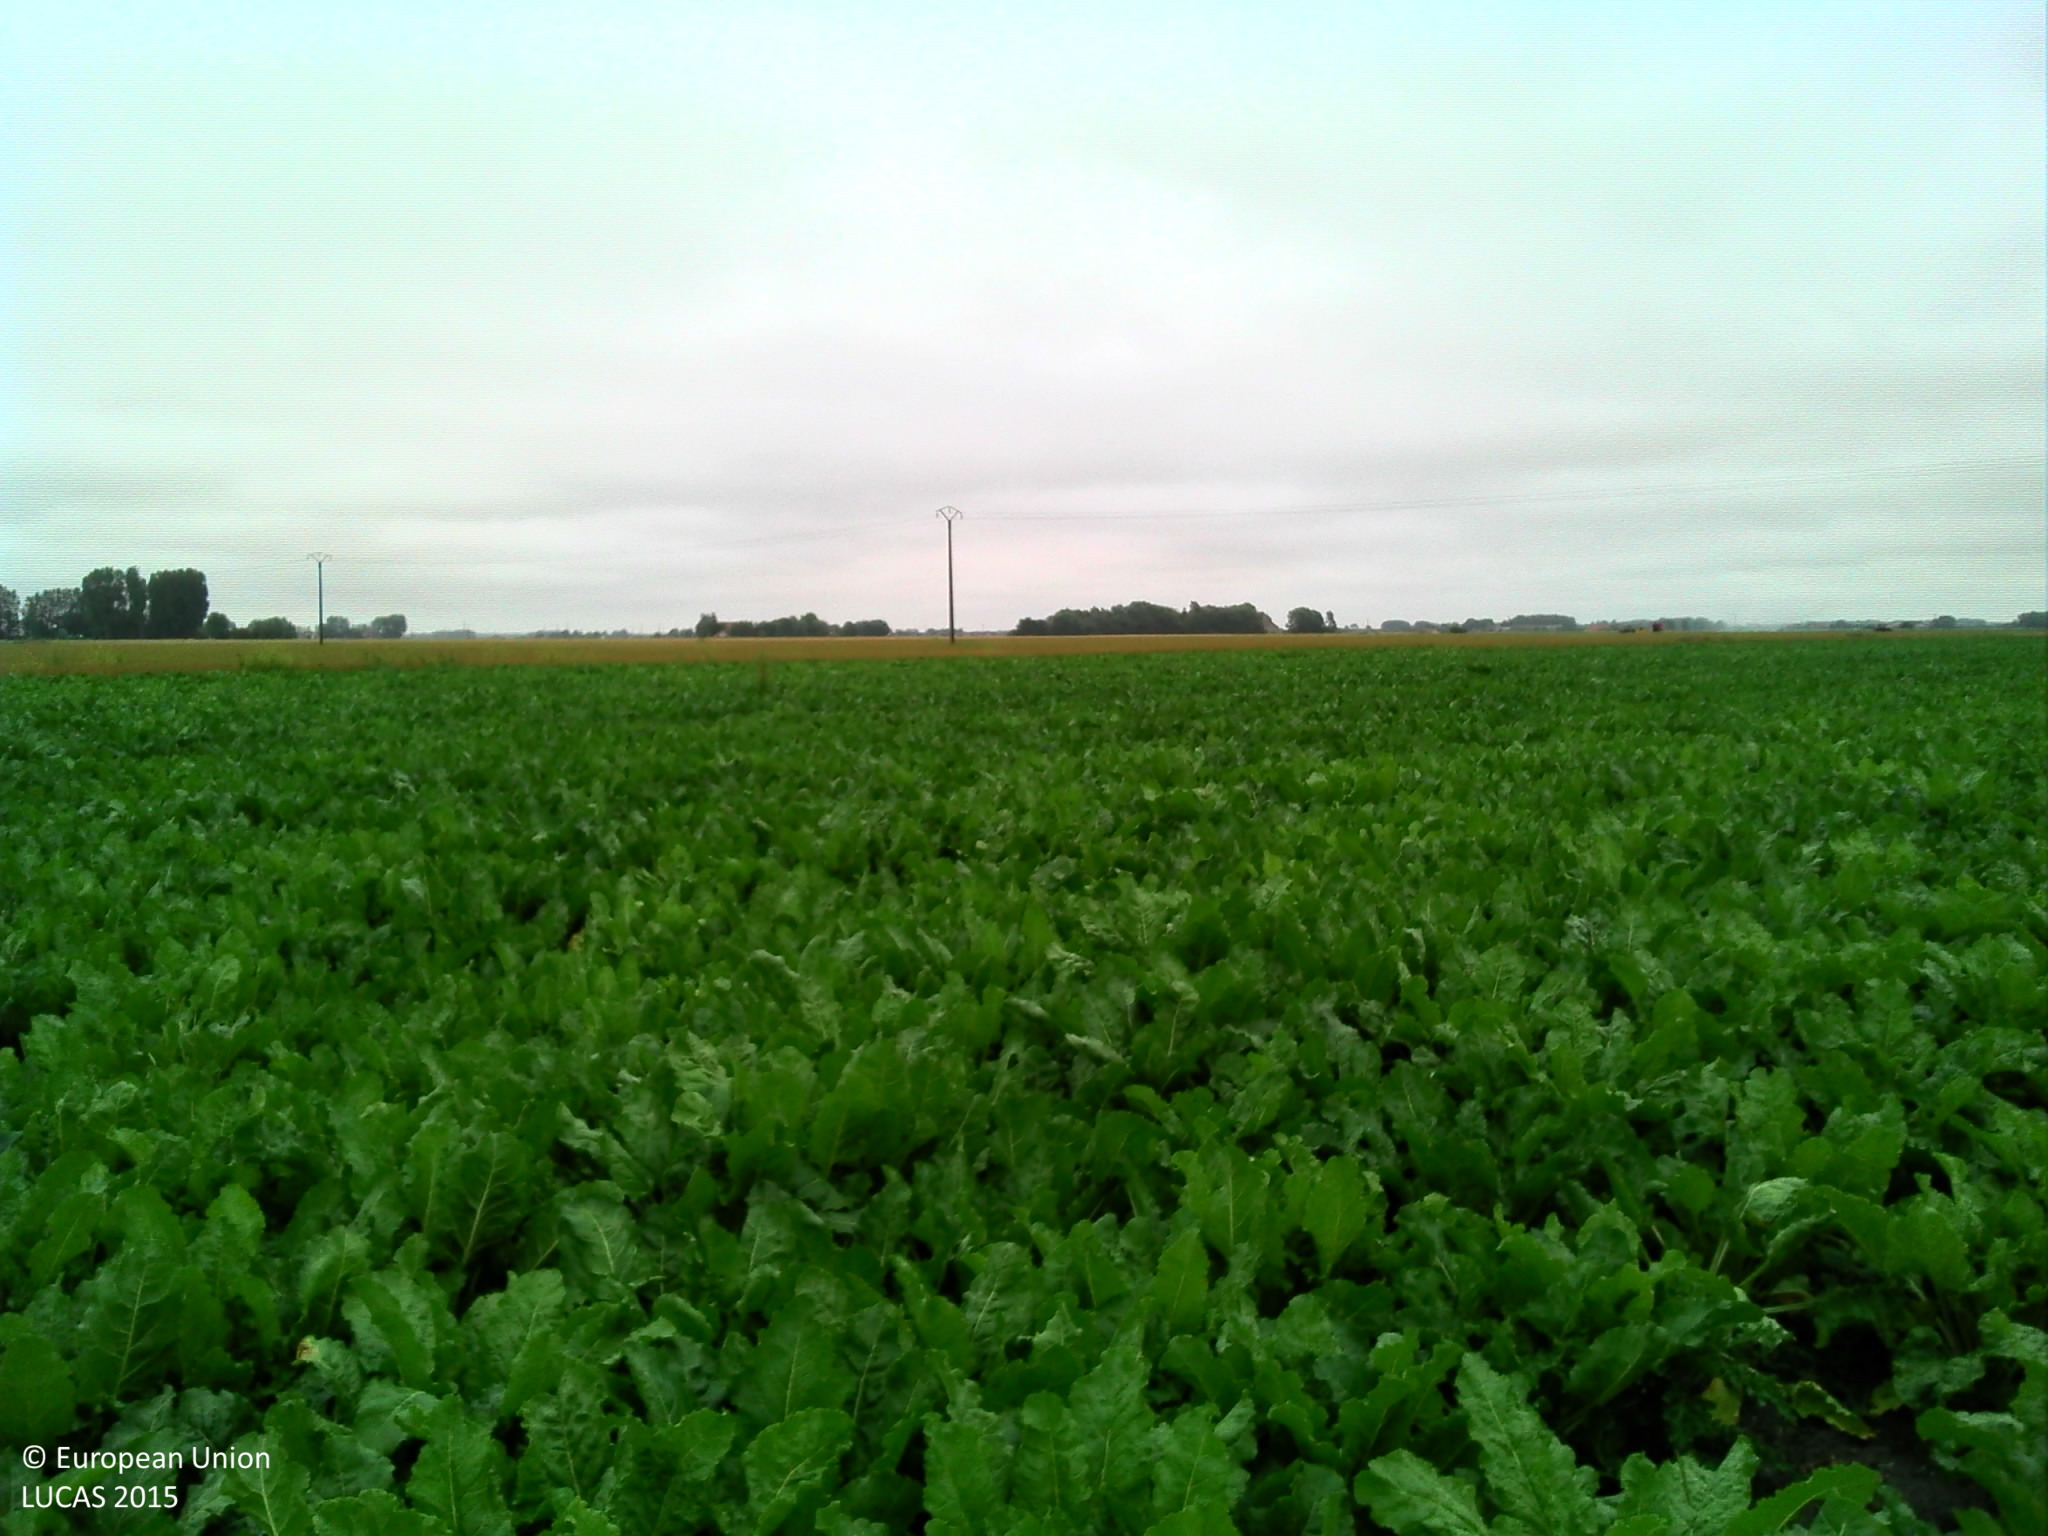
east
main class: Cropland
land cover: Common wheat
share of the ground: > 75 %
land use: Agriculture (excluding fallow land and kitchen gardens)
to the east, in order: Common wheat; Sugar beet; Electric lines; Sugar beet; Grass margins; Common wheat
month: July
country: FR
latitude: 50.9701
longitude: 2.2818
